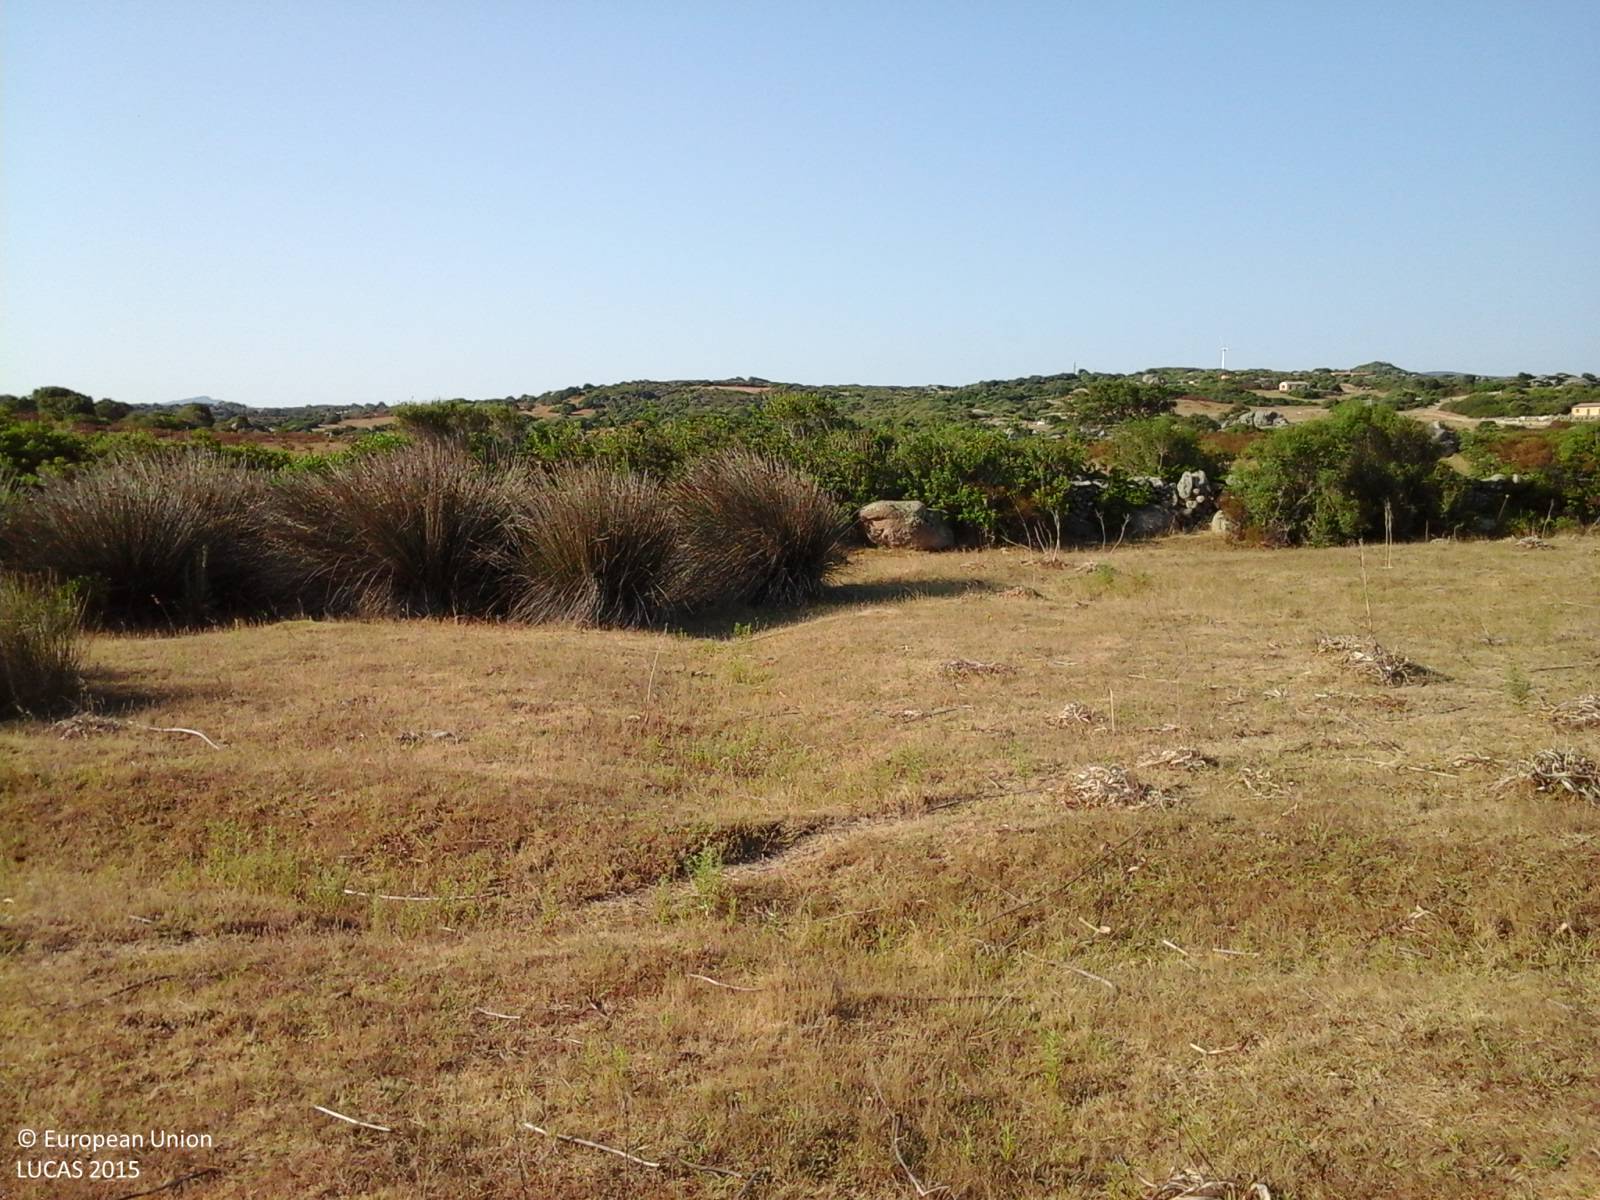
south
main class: Grassland
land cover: Grassland with sparse tree/shrub cover
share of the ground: > 75 %
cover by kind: herbaceous plants 85 %, shrubs 10 %, broadleaved forest trees 5 %
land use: Agriculture (excluding fallow land and kitchen gardens)
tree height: < 5 m
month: July
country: IT
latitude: 41.1151
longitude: 9.2768
